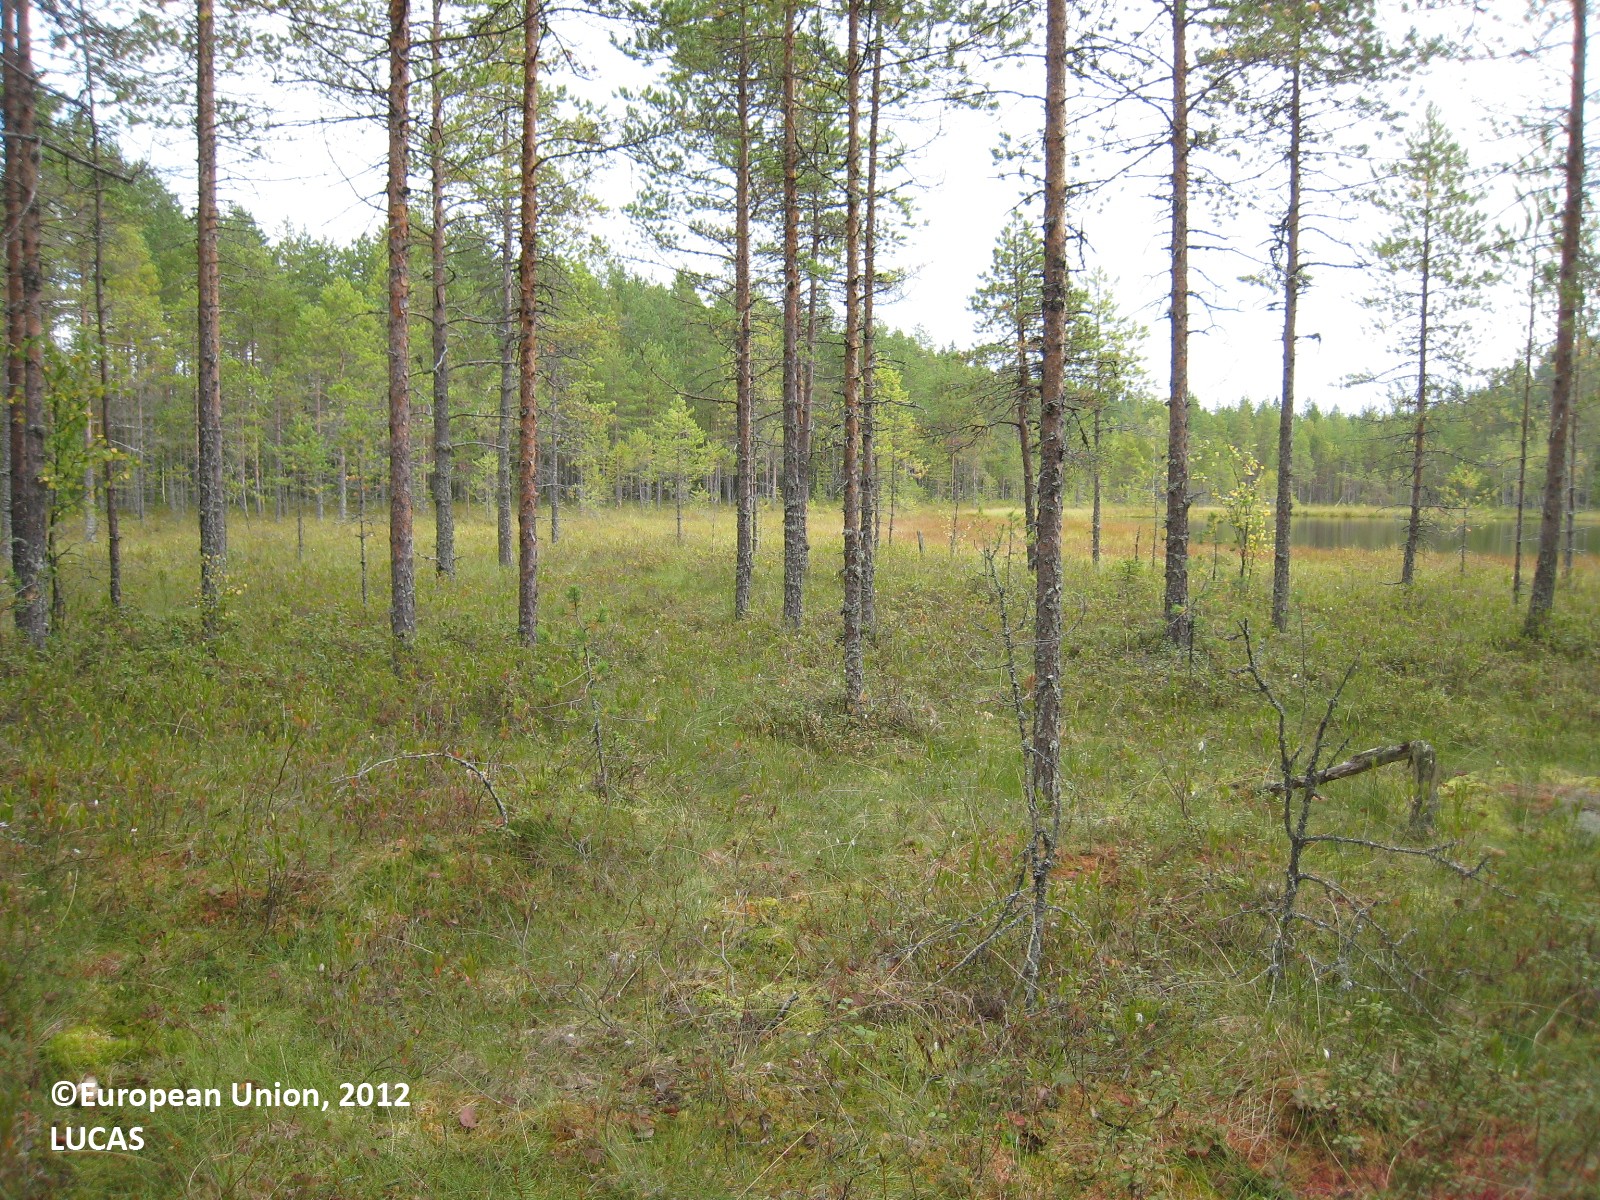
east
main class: Woodland
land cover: Pine dominated coniferous woodland
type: mire and swamp forests
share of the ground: 50 - 75 %
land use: Forestry
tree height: > 5 m
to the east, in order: Pine dominated coniferous woodland; Inland marshes; Pine dominated coniferous woodland; Ditches and canals; Pine dominated mixed woodland; Other mixed woodland; Ditches and canals; Spruce dominated mixed woodland; Other coniferous woodland
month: August
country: FI
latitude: 62.3633
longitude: 27.2632
